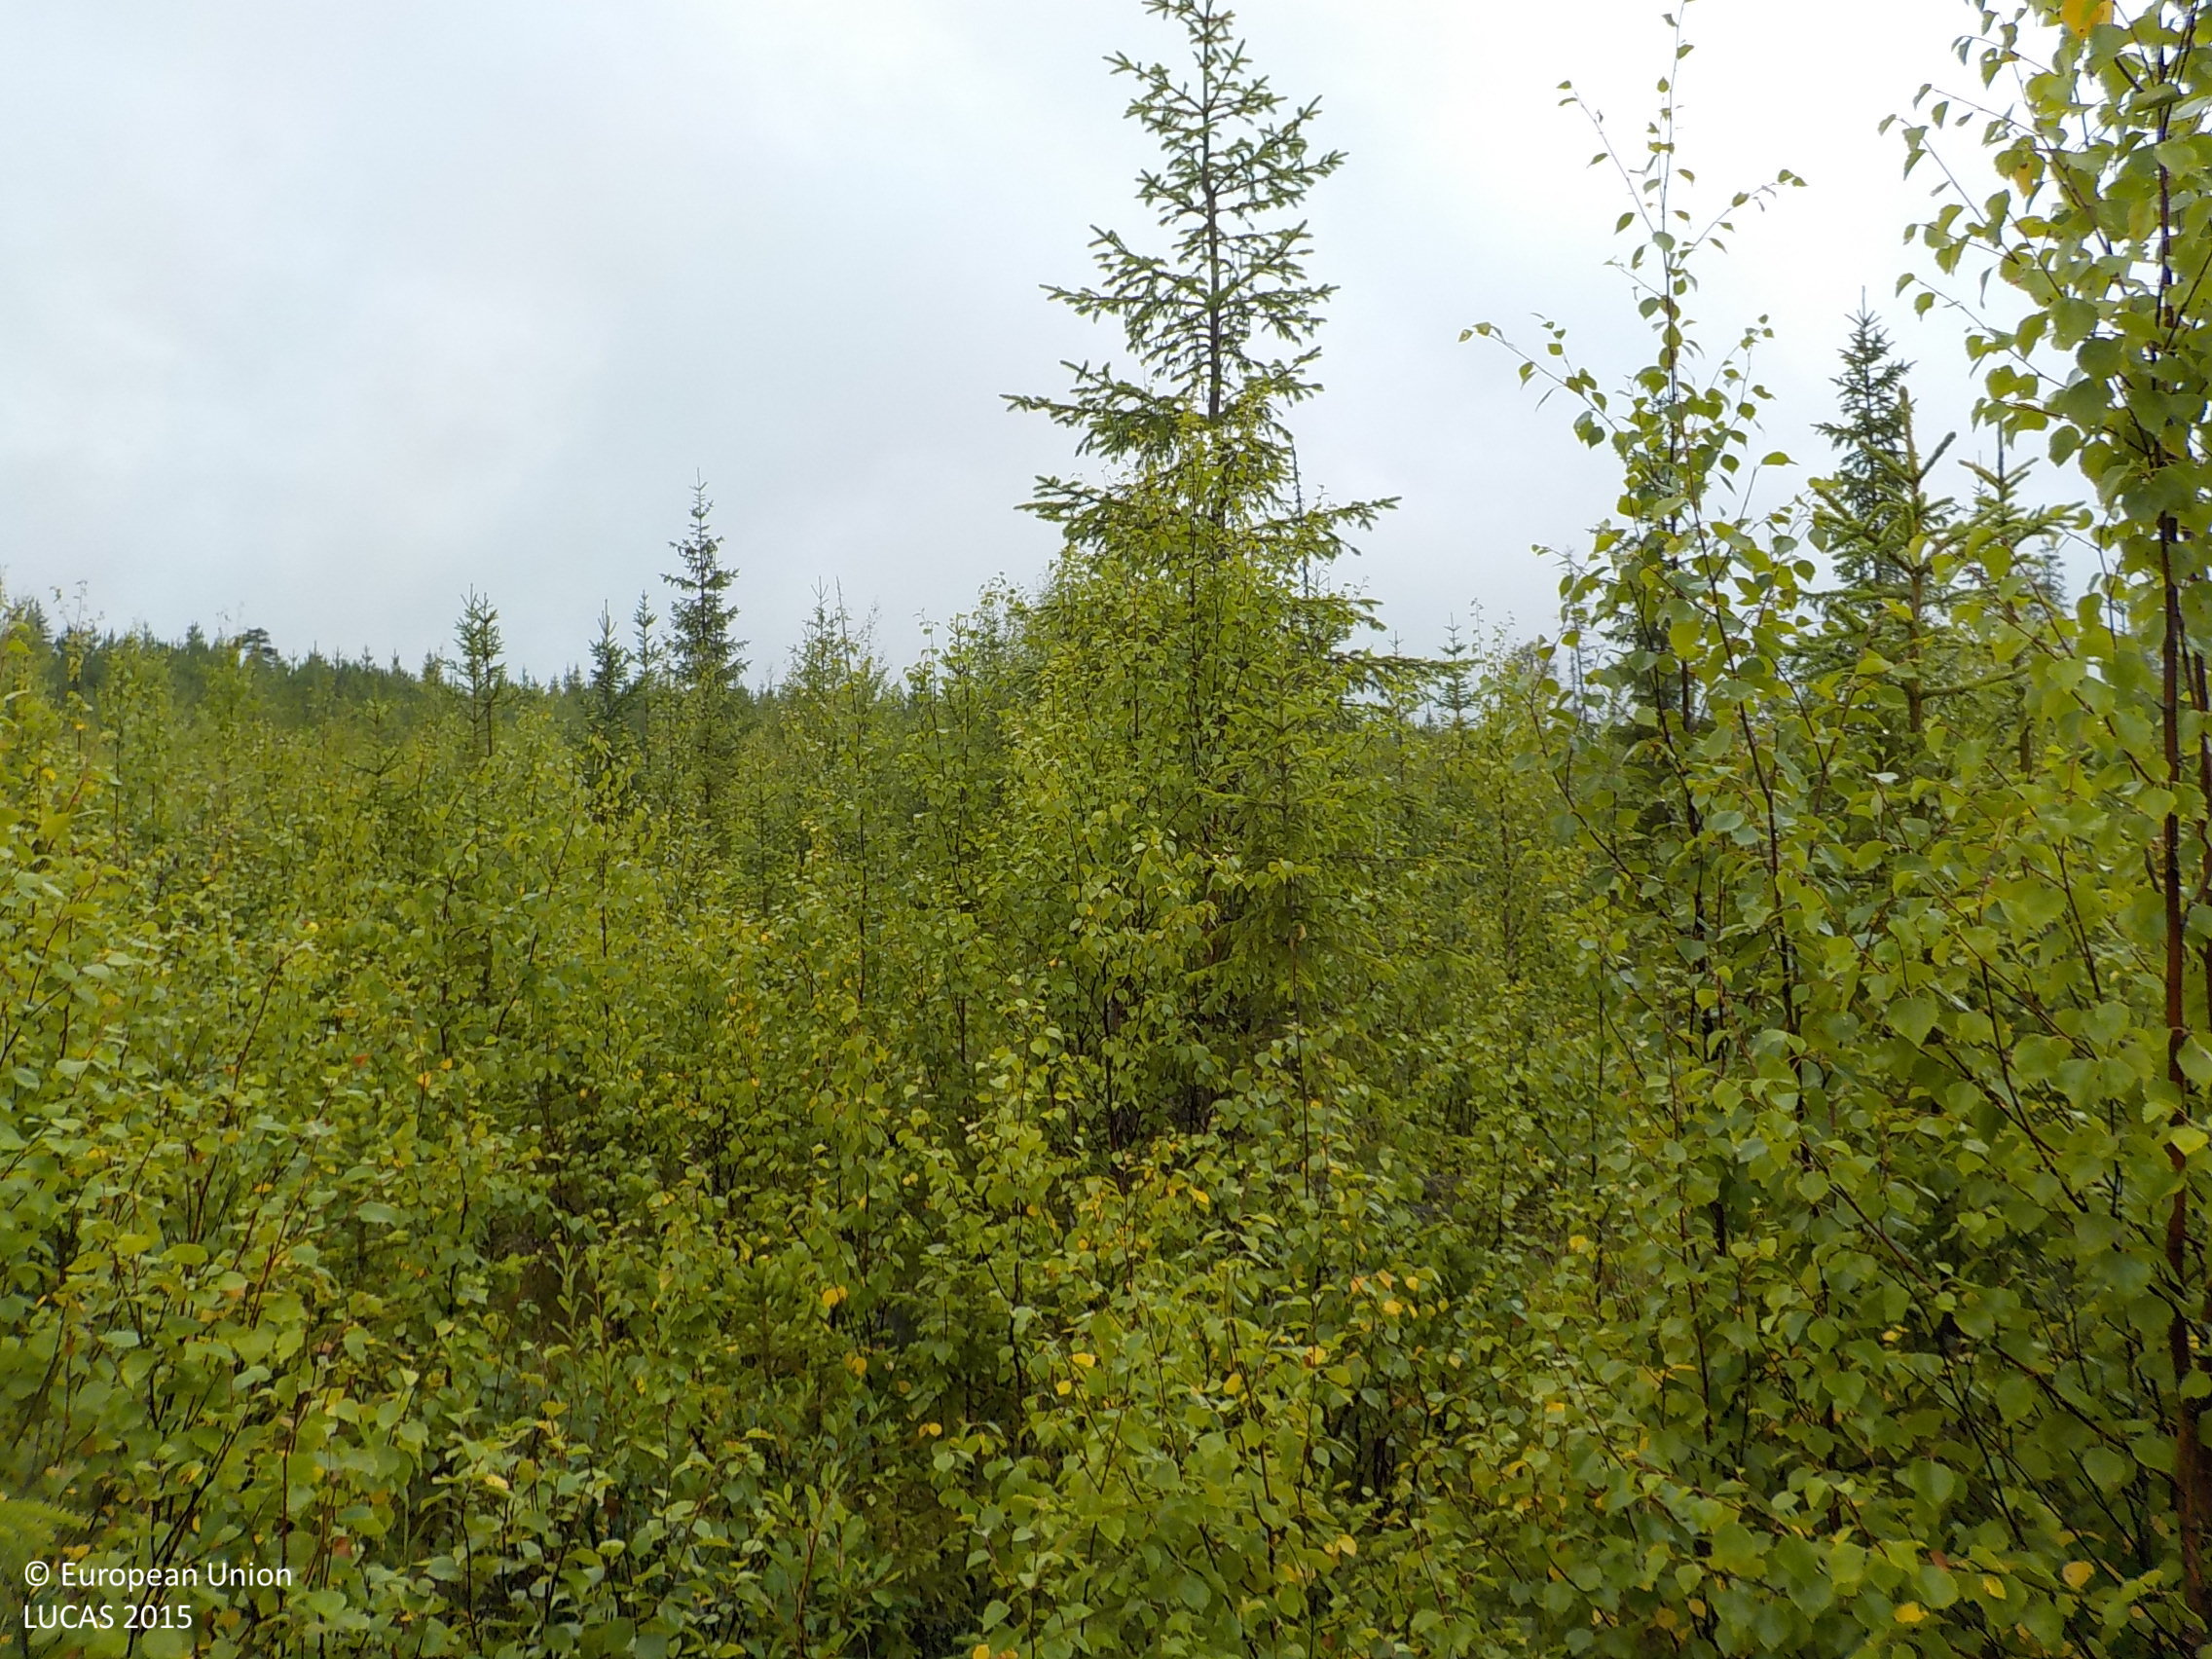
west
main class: Woodland
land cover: Spruce dominated mixed woodland
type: boreal forest
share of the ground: 50 - 75 %
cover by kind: broadleaved forest trees 40 %, coniferous forest trees 30 %, herbaceous plants 20 %, shrubs 10 %
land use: Forestry
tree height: < 5 m
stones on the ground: > 50 %
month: August
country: SE
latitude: 63.7966
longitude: 17.2590
